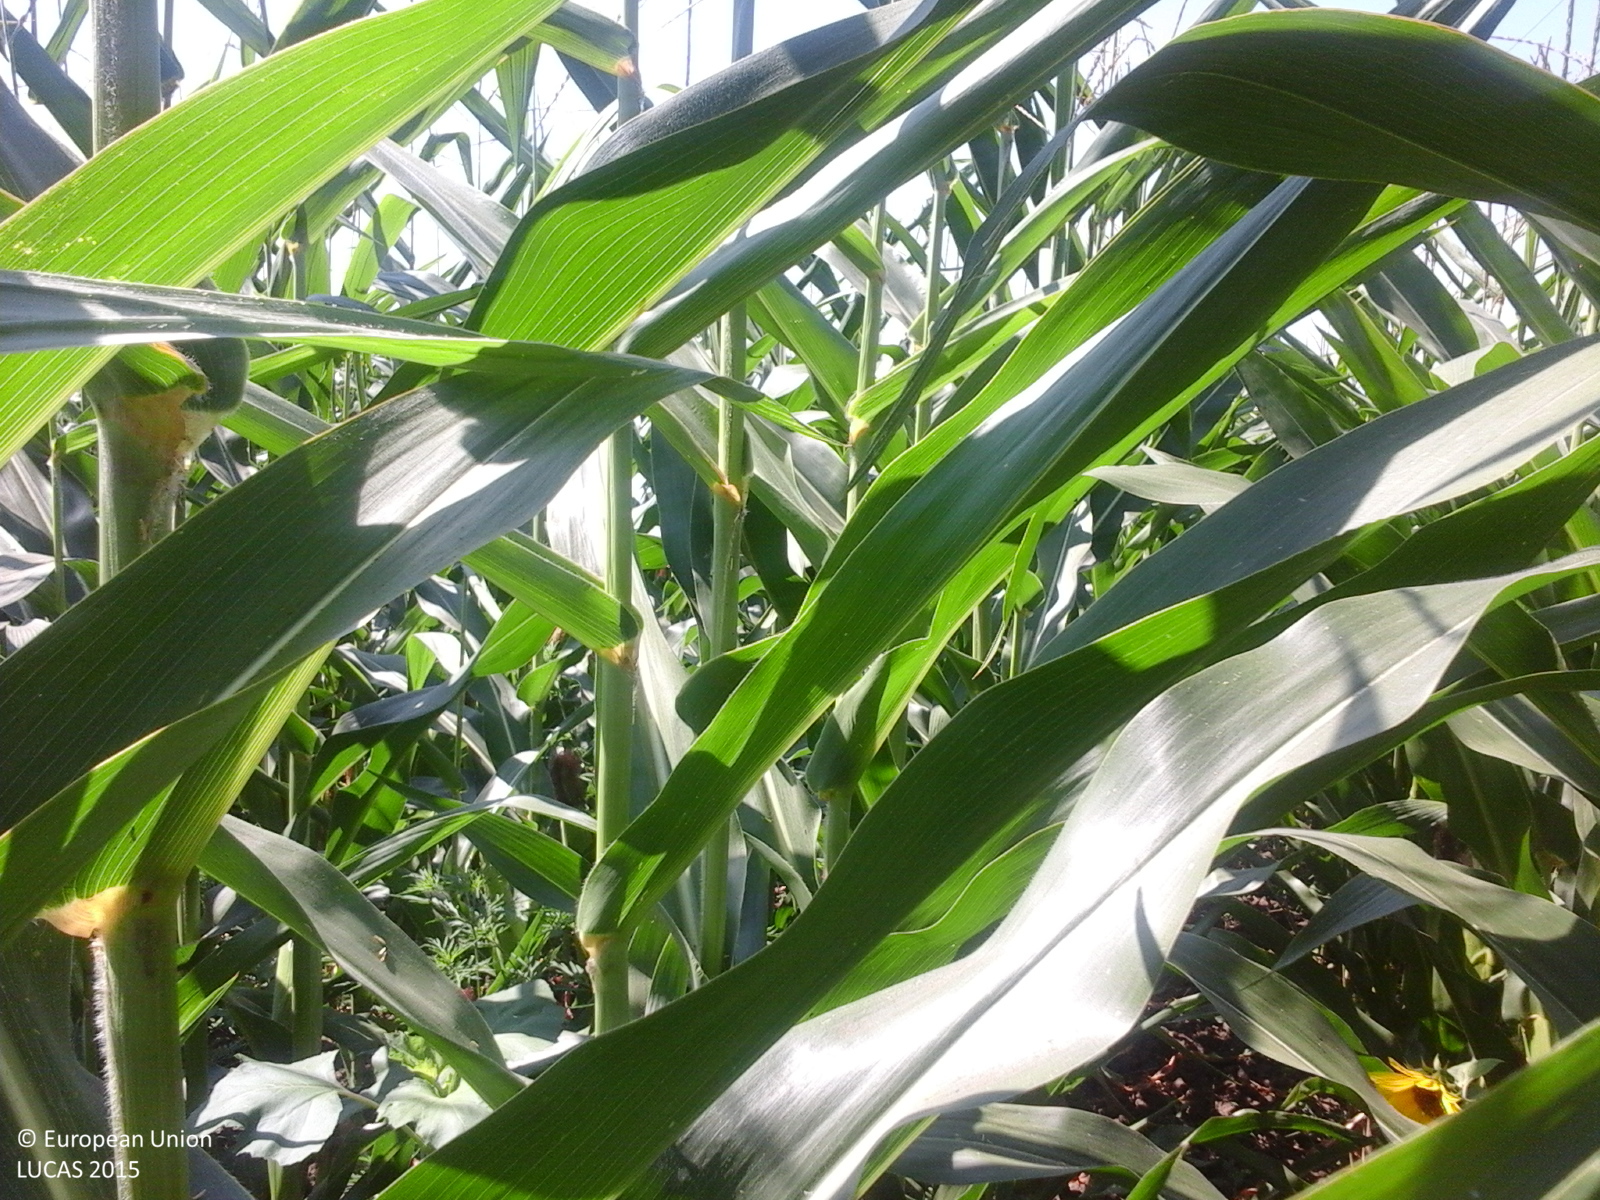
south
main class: Cropland
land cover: Maize
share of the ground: > 75 %
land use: Agriculture (excluding fallow land and kitchen gardens)
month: July
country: RO
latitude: 44.6592
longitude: 26.8102
